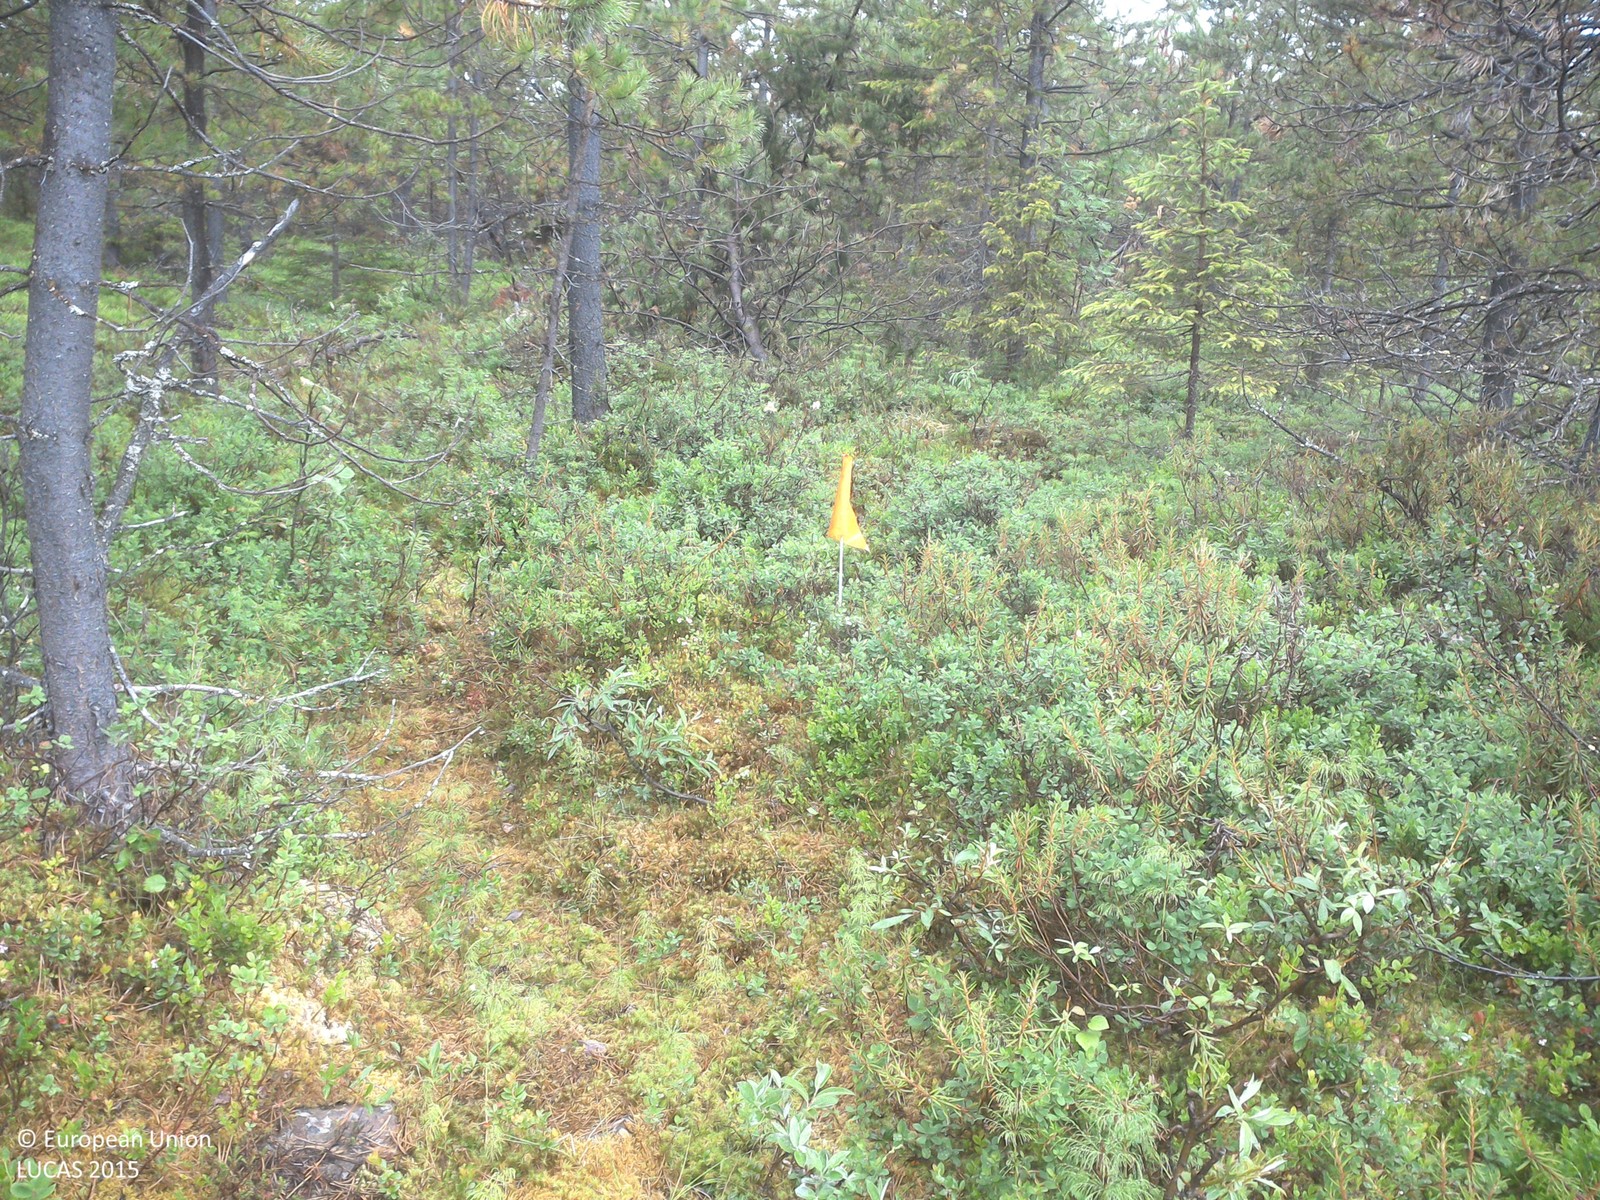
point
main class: Woodland
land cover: Pine dominated coniferous woodland
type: exotic forest
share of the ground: 25 - 50 %
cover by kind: shrubs 70 %, coniferous forest trees 25 %, lichens and mosses 5 %
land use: Forestry
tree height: > 5 m
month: July
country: SE
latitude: 67.5798
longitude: 23.1920
